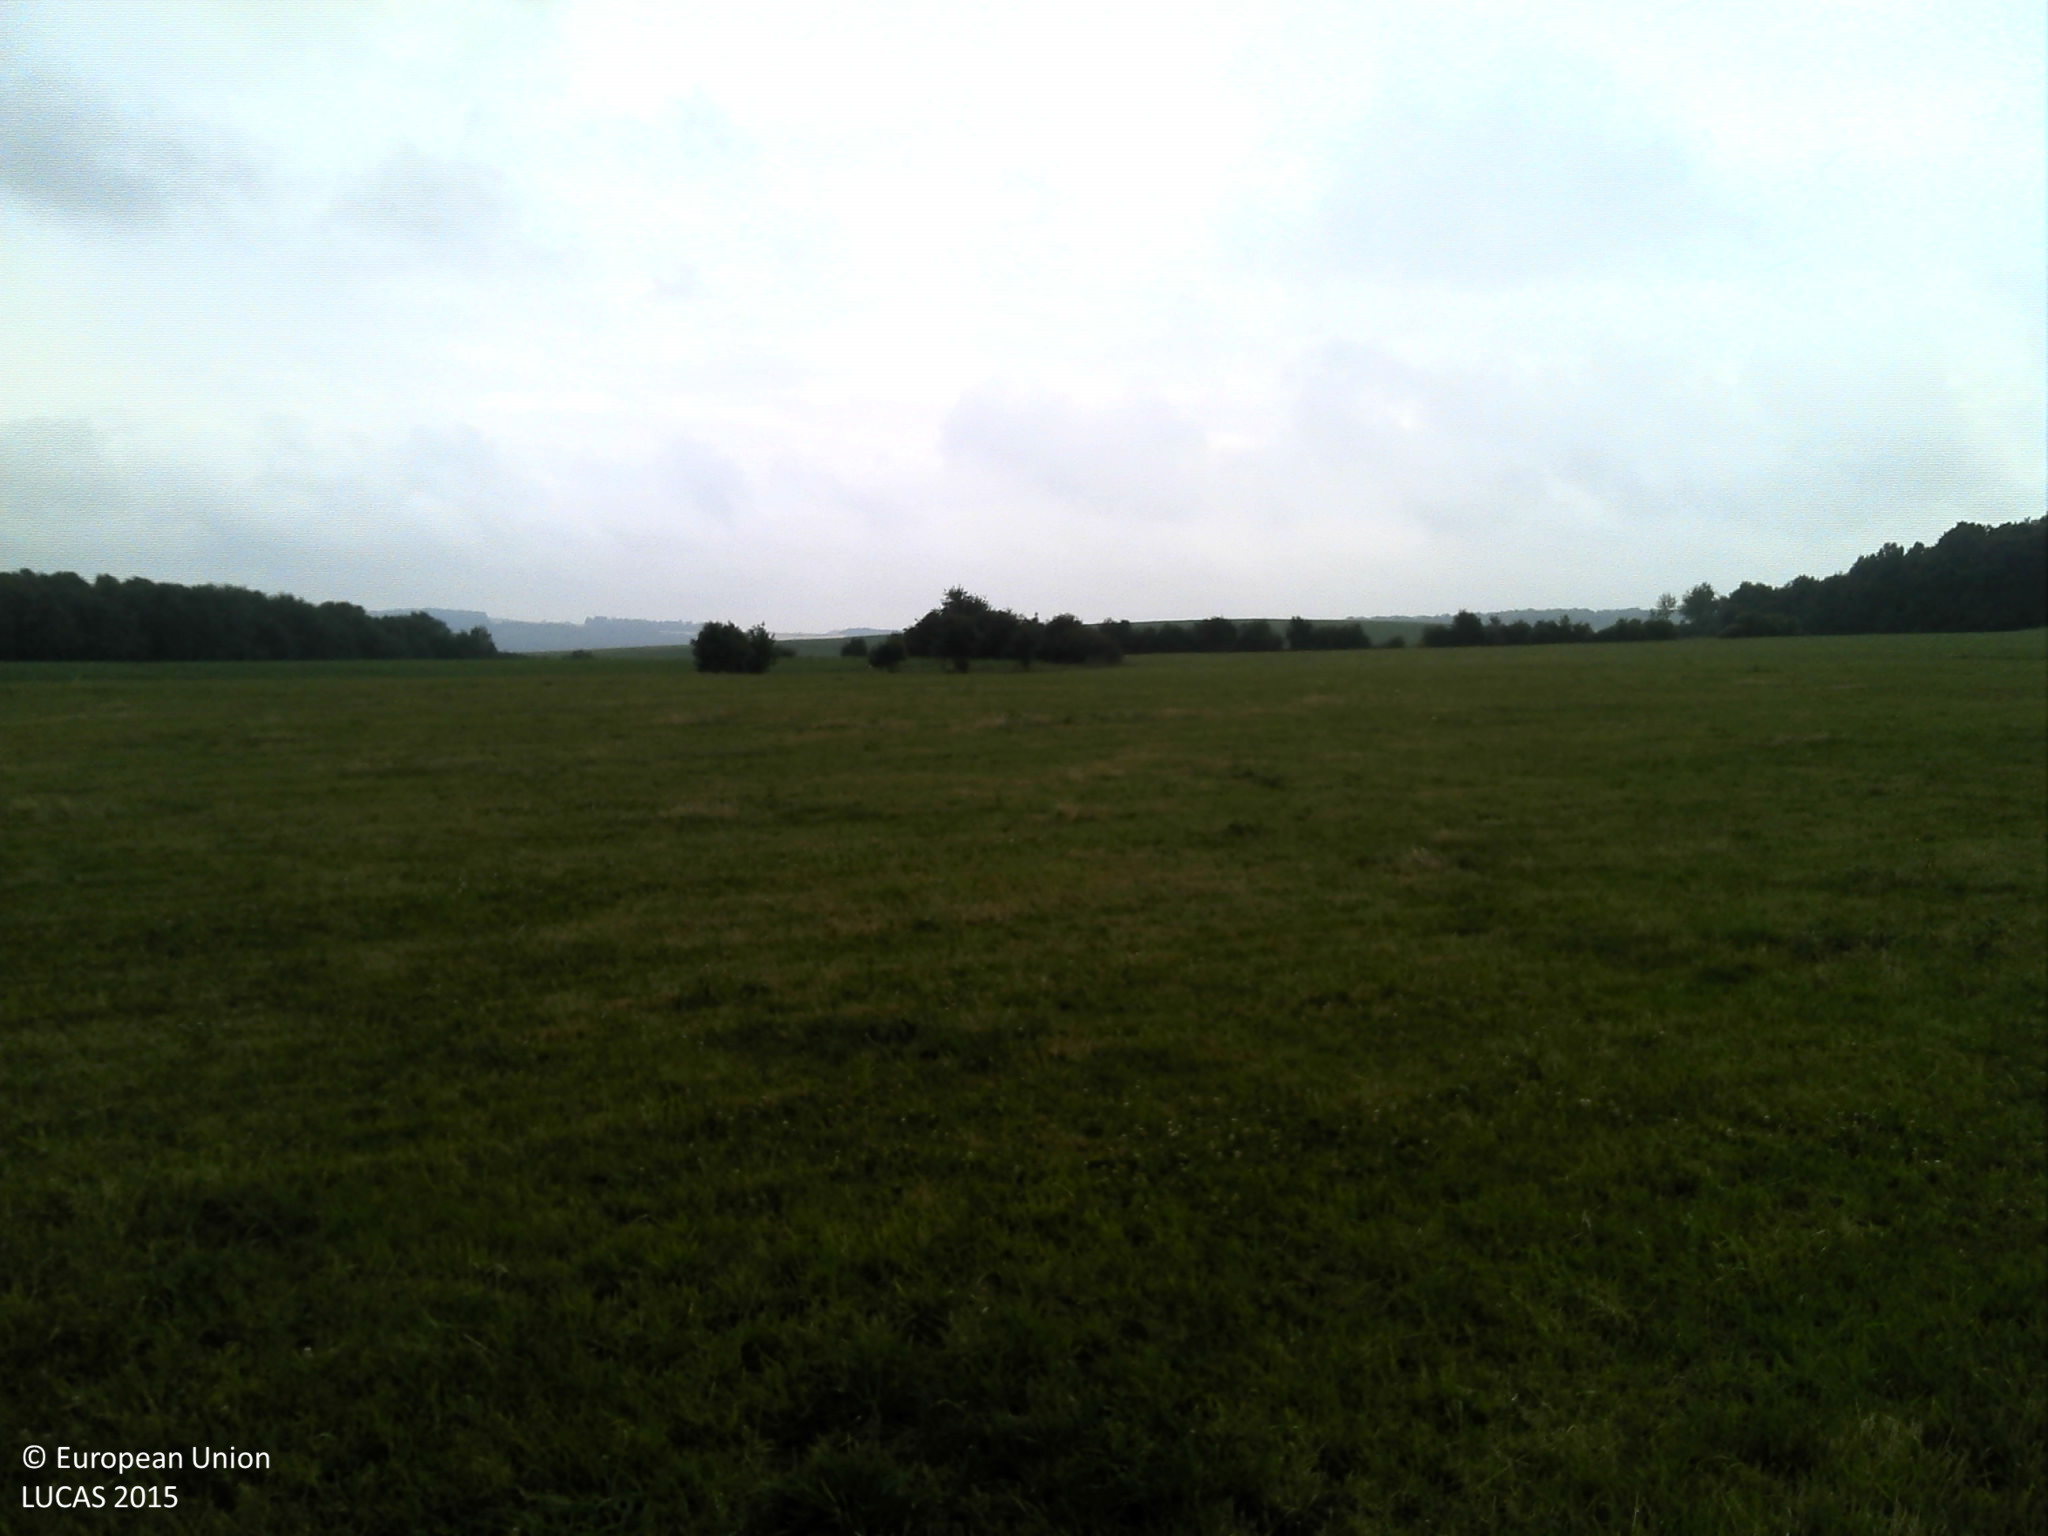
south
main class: Grassland
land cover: Grassland without tree/shrub cover
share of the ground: > 75 %
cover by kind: herbaceous plants 100 %
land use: Agriculture (excluding fallow land and kitchen gardens)
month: July
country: FR
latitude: 49.7166
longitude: 4.6568
